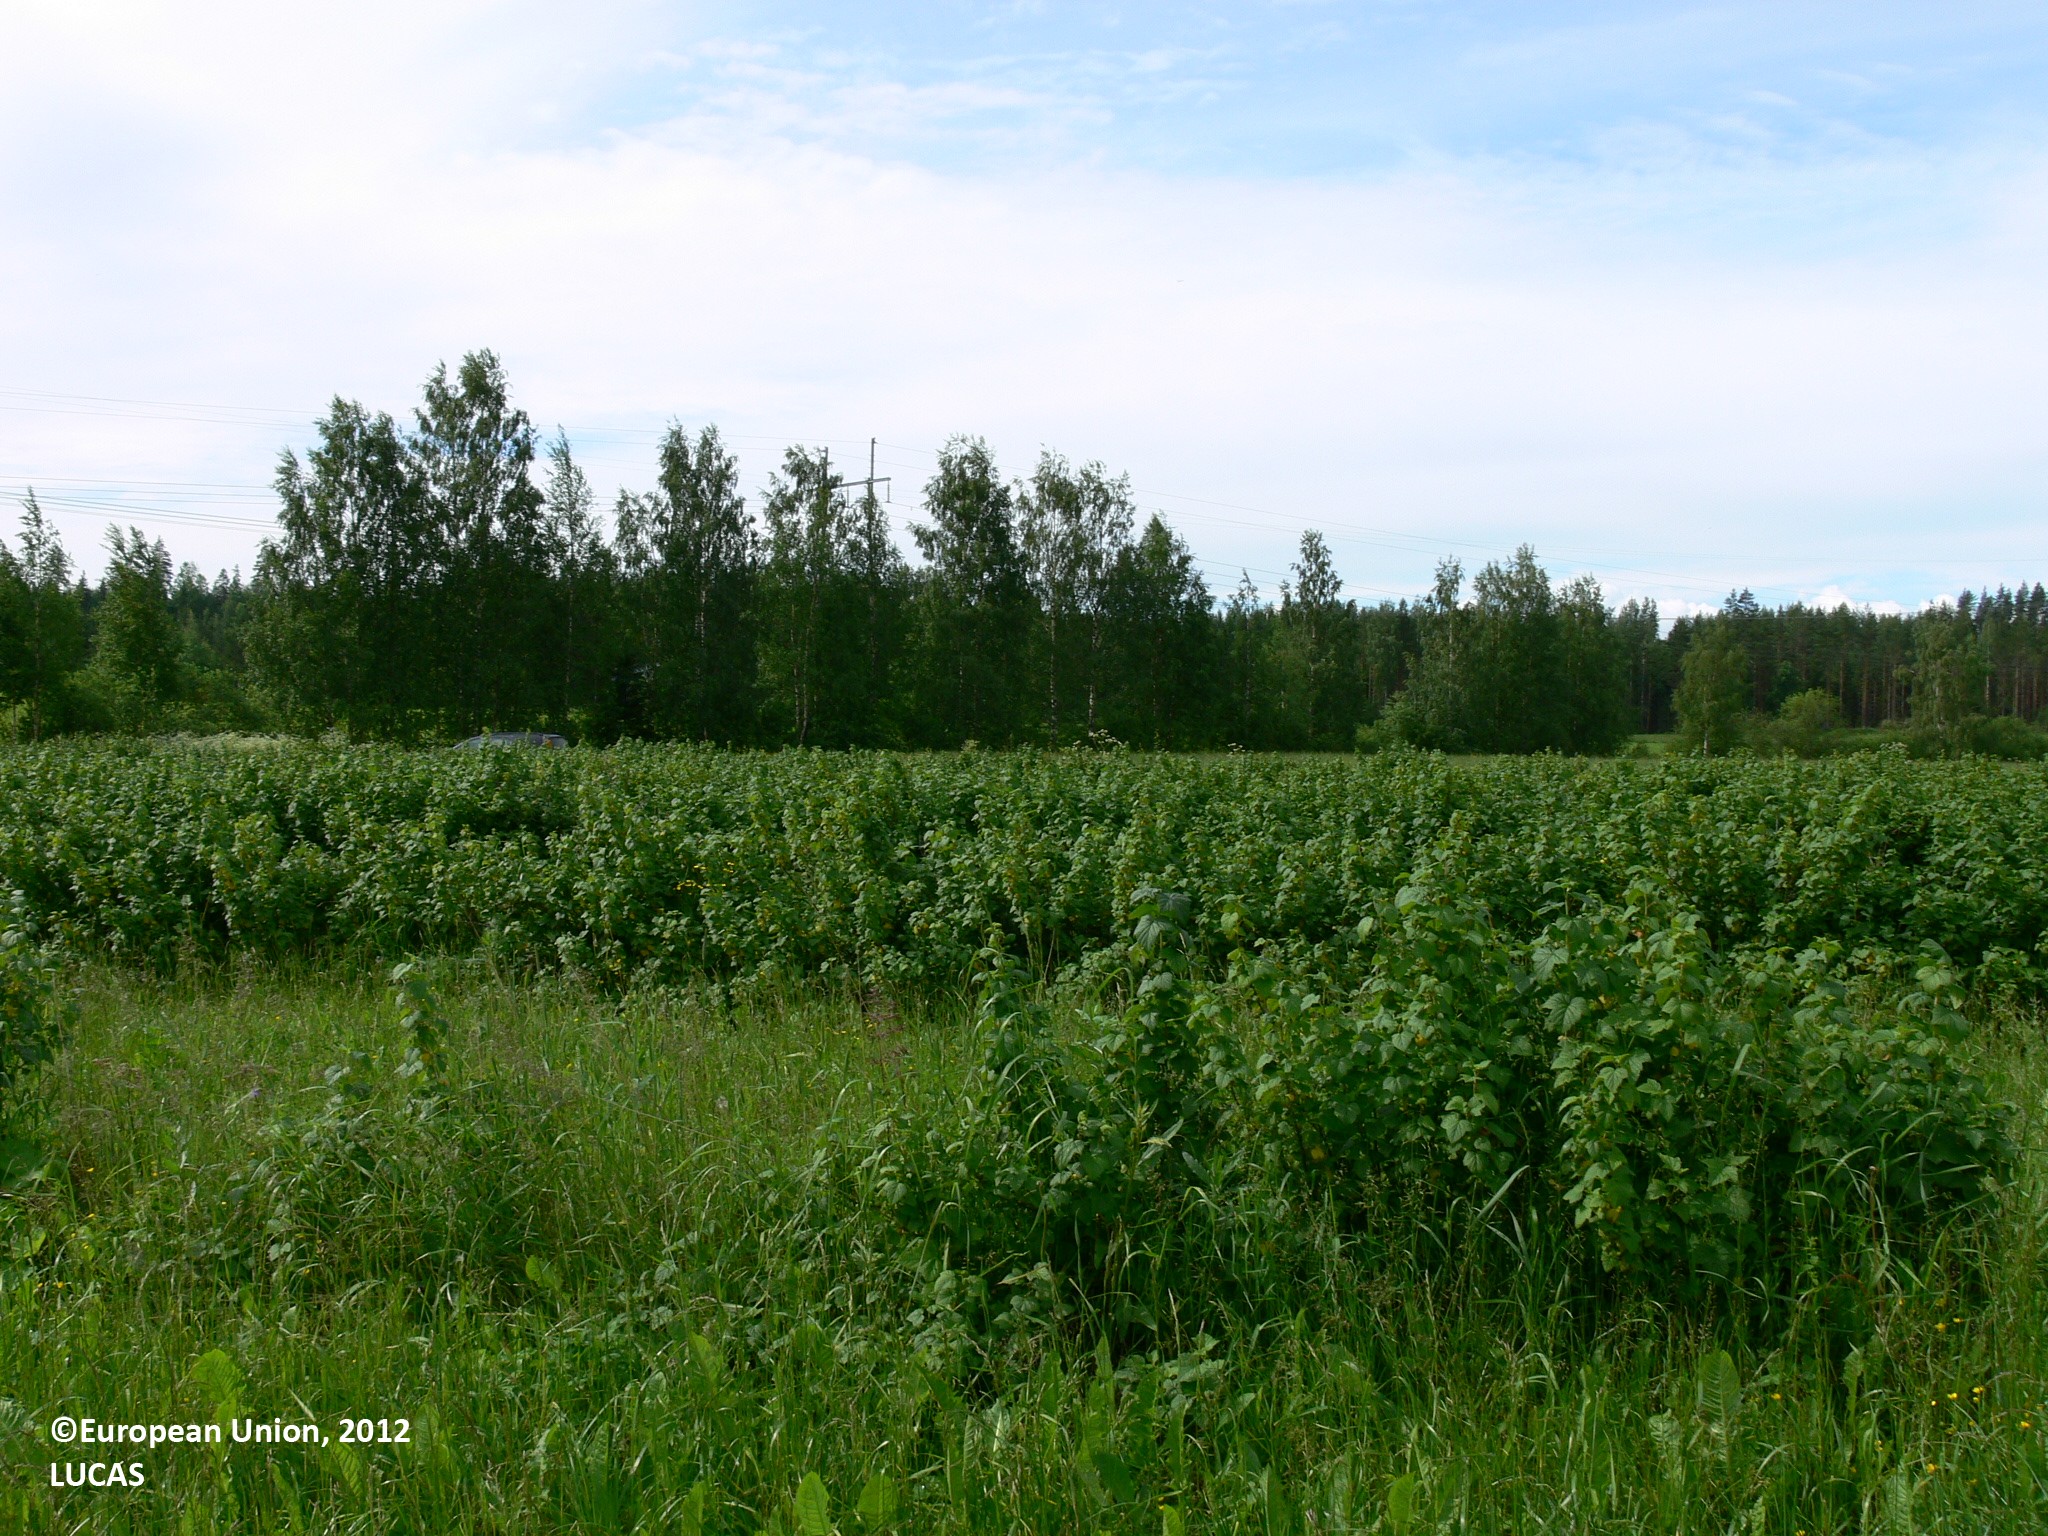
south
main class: Cropland
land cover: Other fruit trees and berries
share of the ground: 25 - 50 %
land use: Agriculture (excluding fallow land and kitchen gardens)
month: June
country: FI
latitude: 62.6445
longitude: 29.4908
